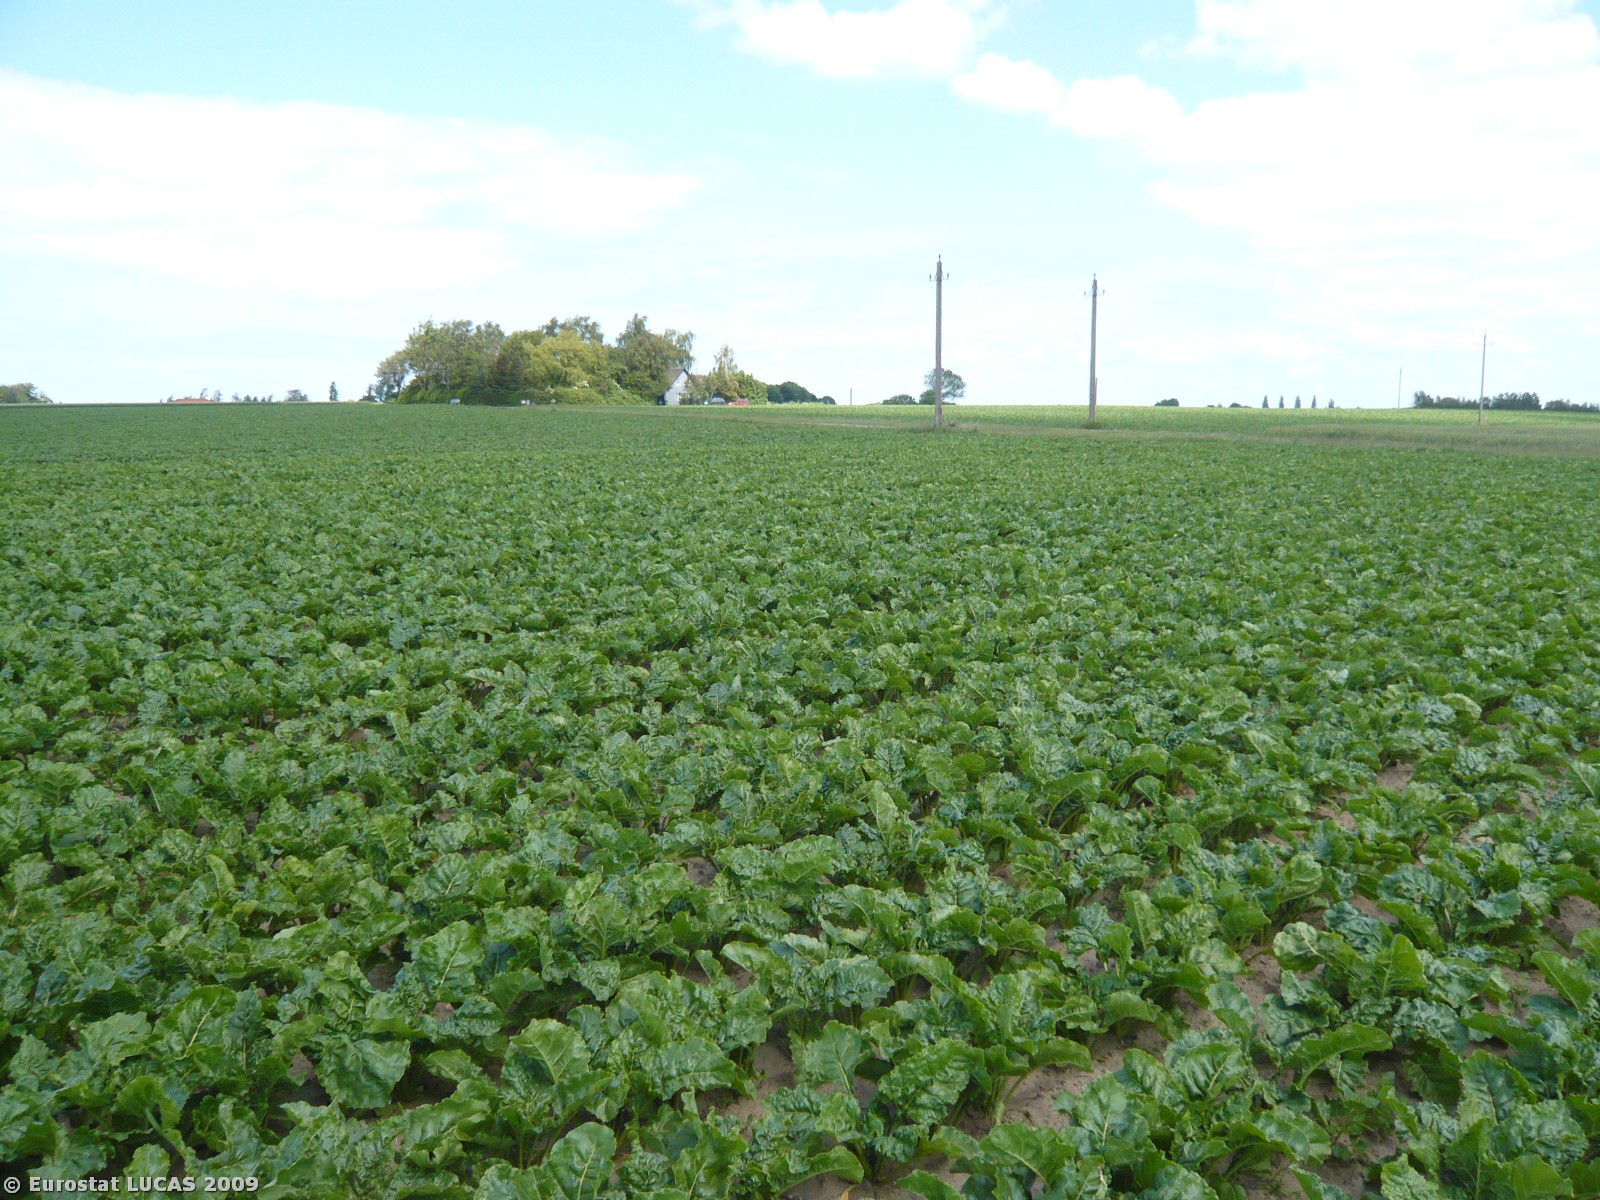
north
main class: Cropland
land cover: Sugar beet
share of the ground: > 75 %
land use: Agriculture (excluding fallow land and kitchen gardens)
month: June
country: DK
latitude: 54.8869
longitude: 11.2930
